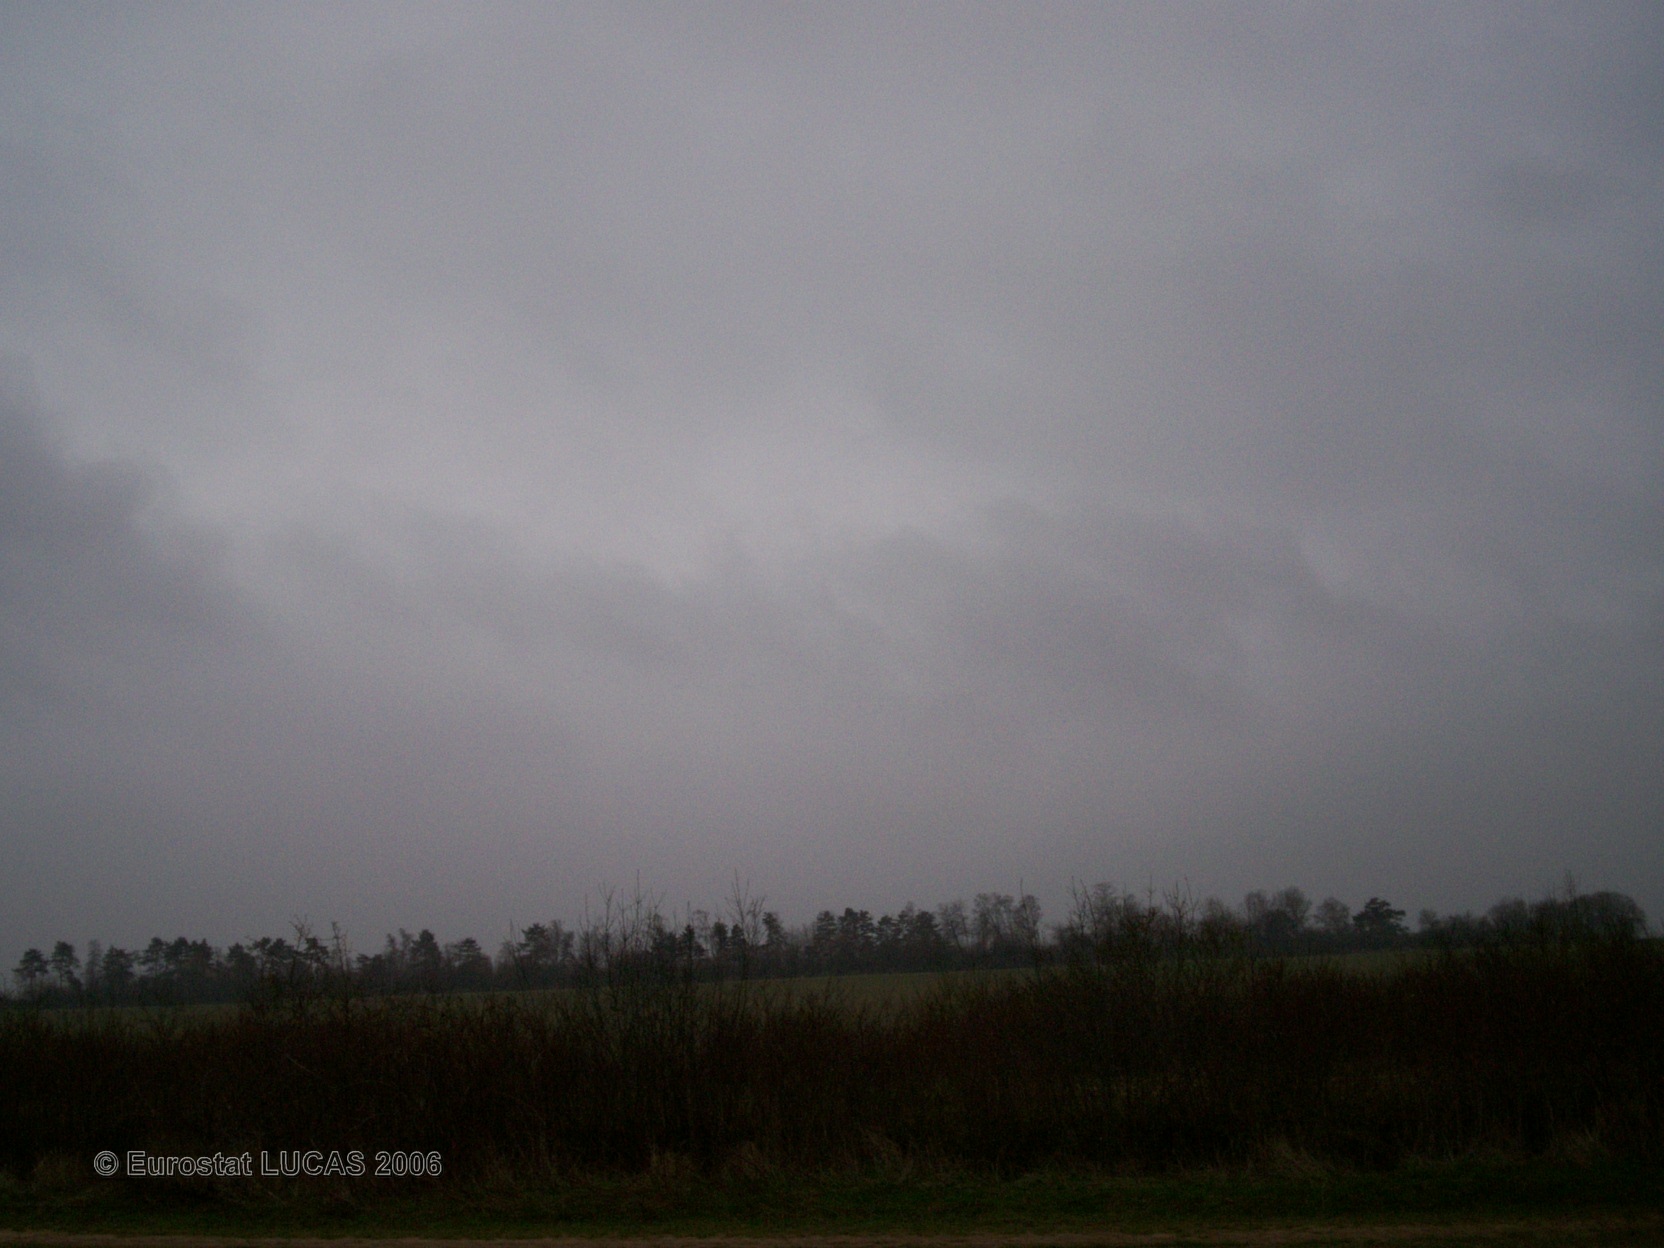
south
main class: Cropland
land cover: Rape and turnip rape
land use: Agriculture (excluding fallow land and kitchen gardens)
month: April
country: FR
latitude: 49.2451
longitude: 4.5982
